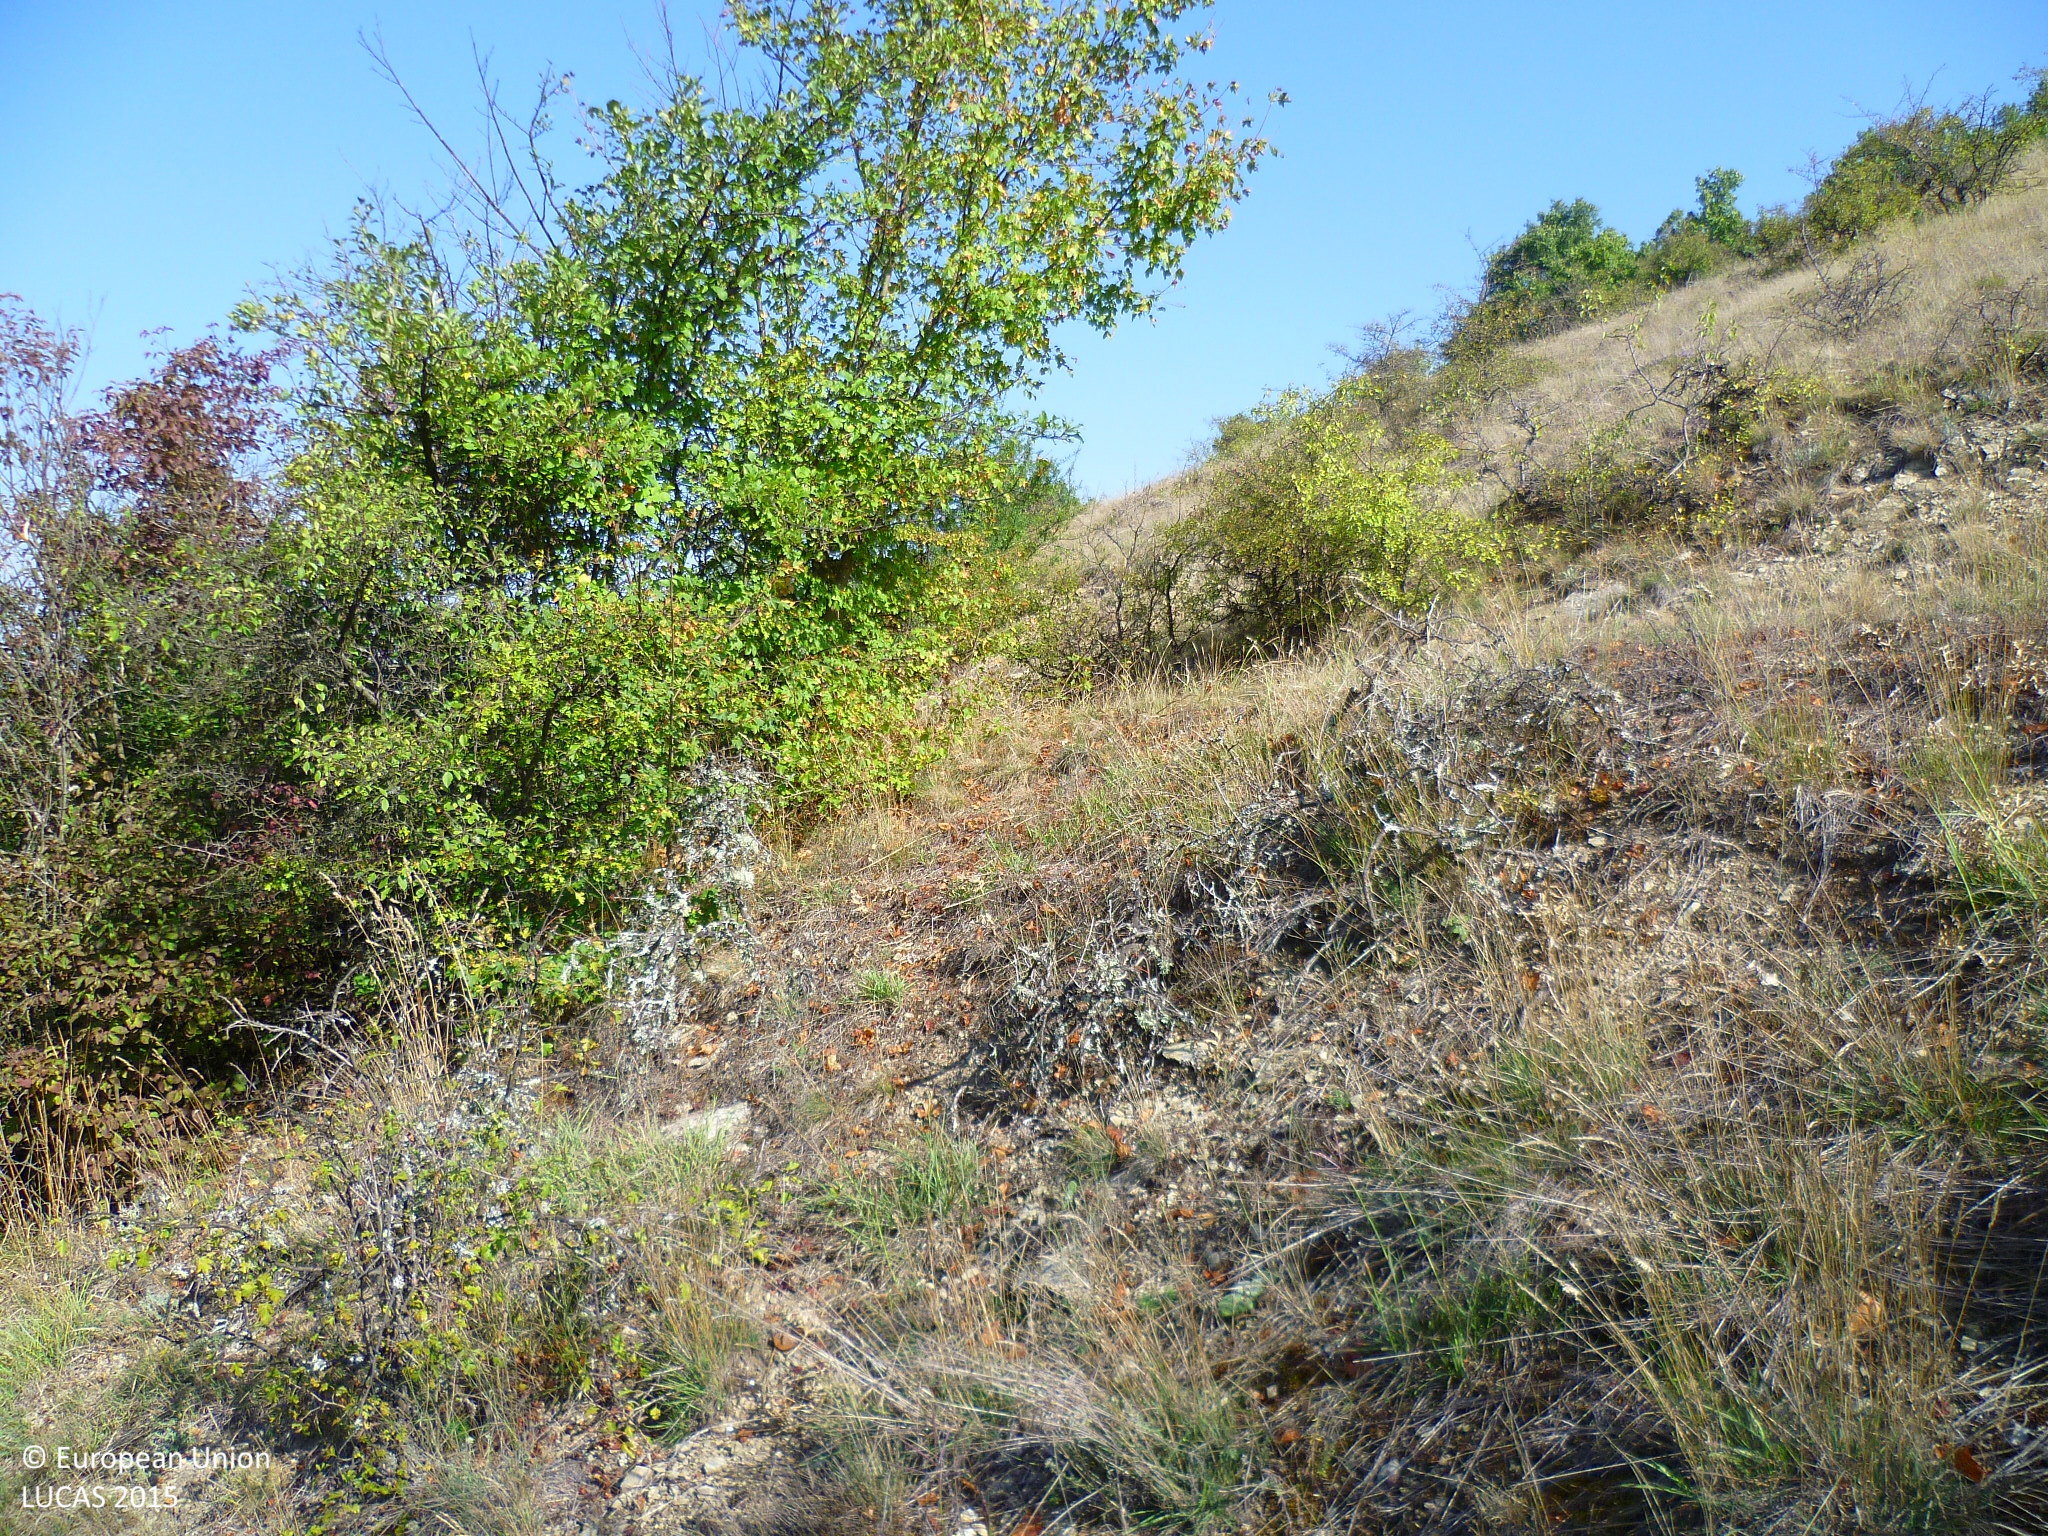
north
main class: Shrubland
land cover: Shrubland with sparse tree cover
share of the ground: 50 - 75 %
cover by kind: shrubs 55 %, herbaceous plants 40 %, broadleaved forest trees 5 %
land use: Semi-natural and natural areas not in use
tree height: < 5 m
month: September
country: BG
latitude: 42.8816
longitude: 22.9226
